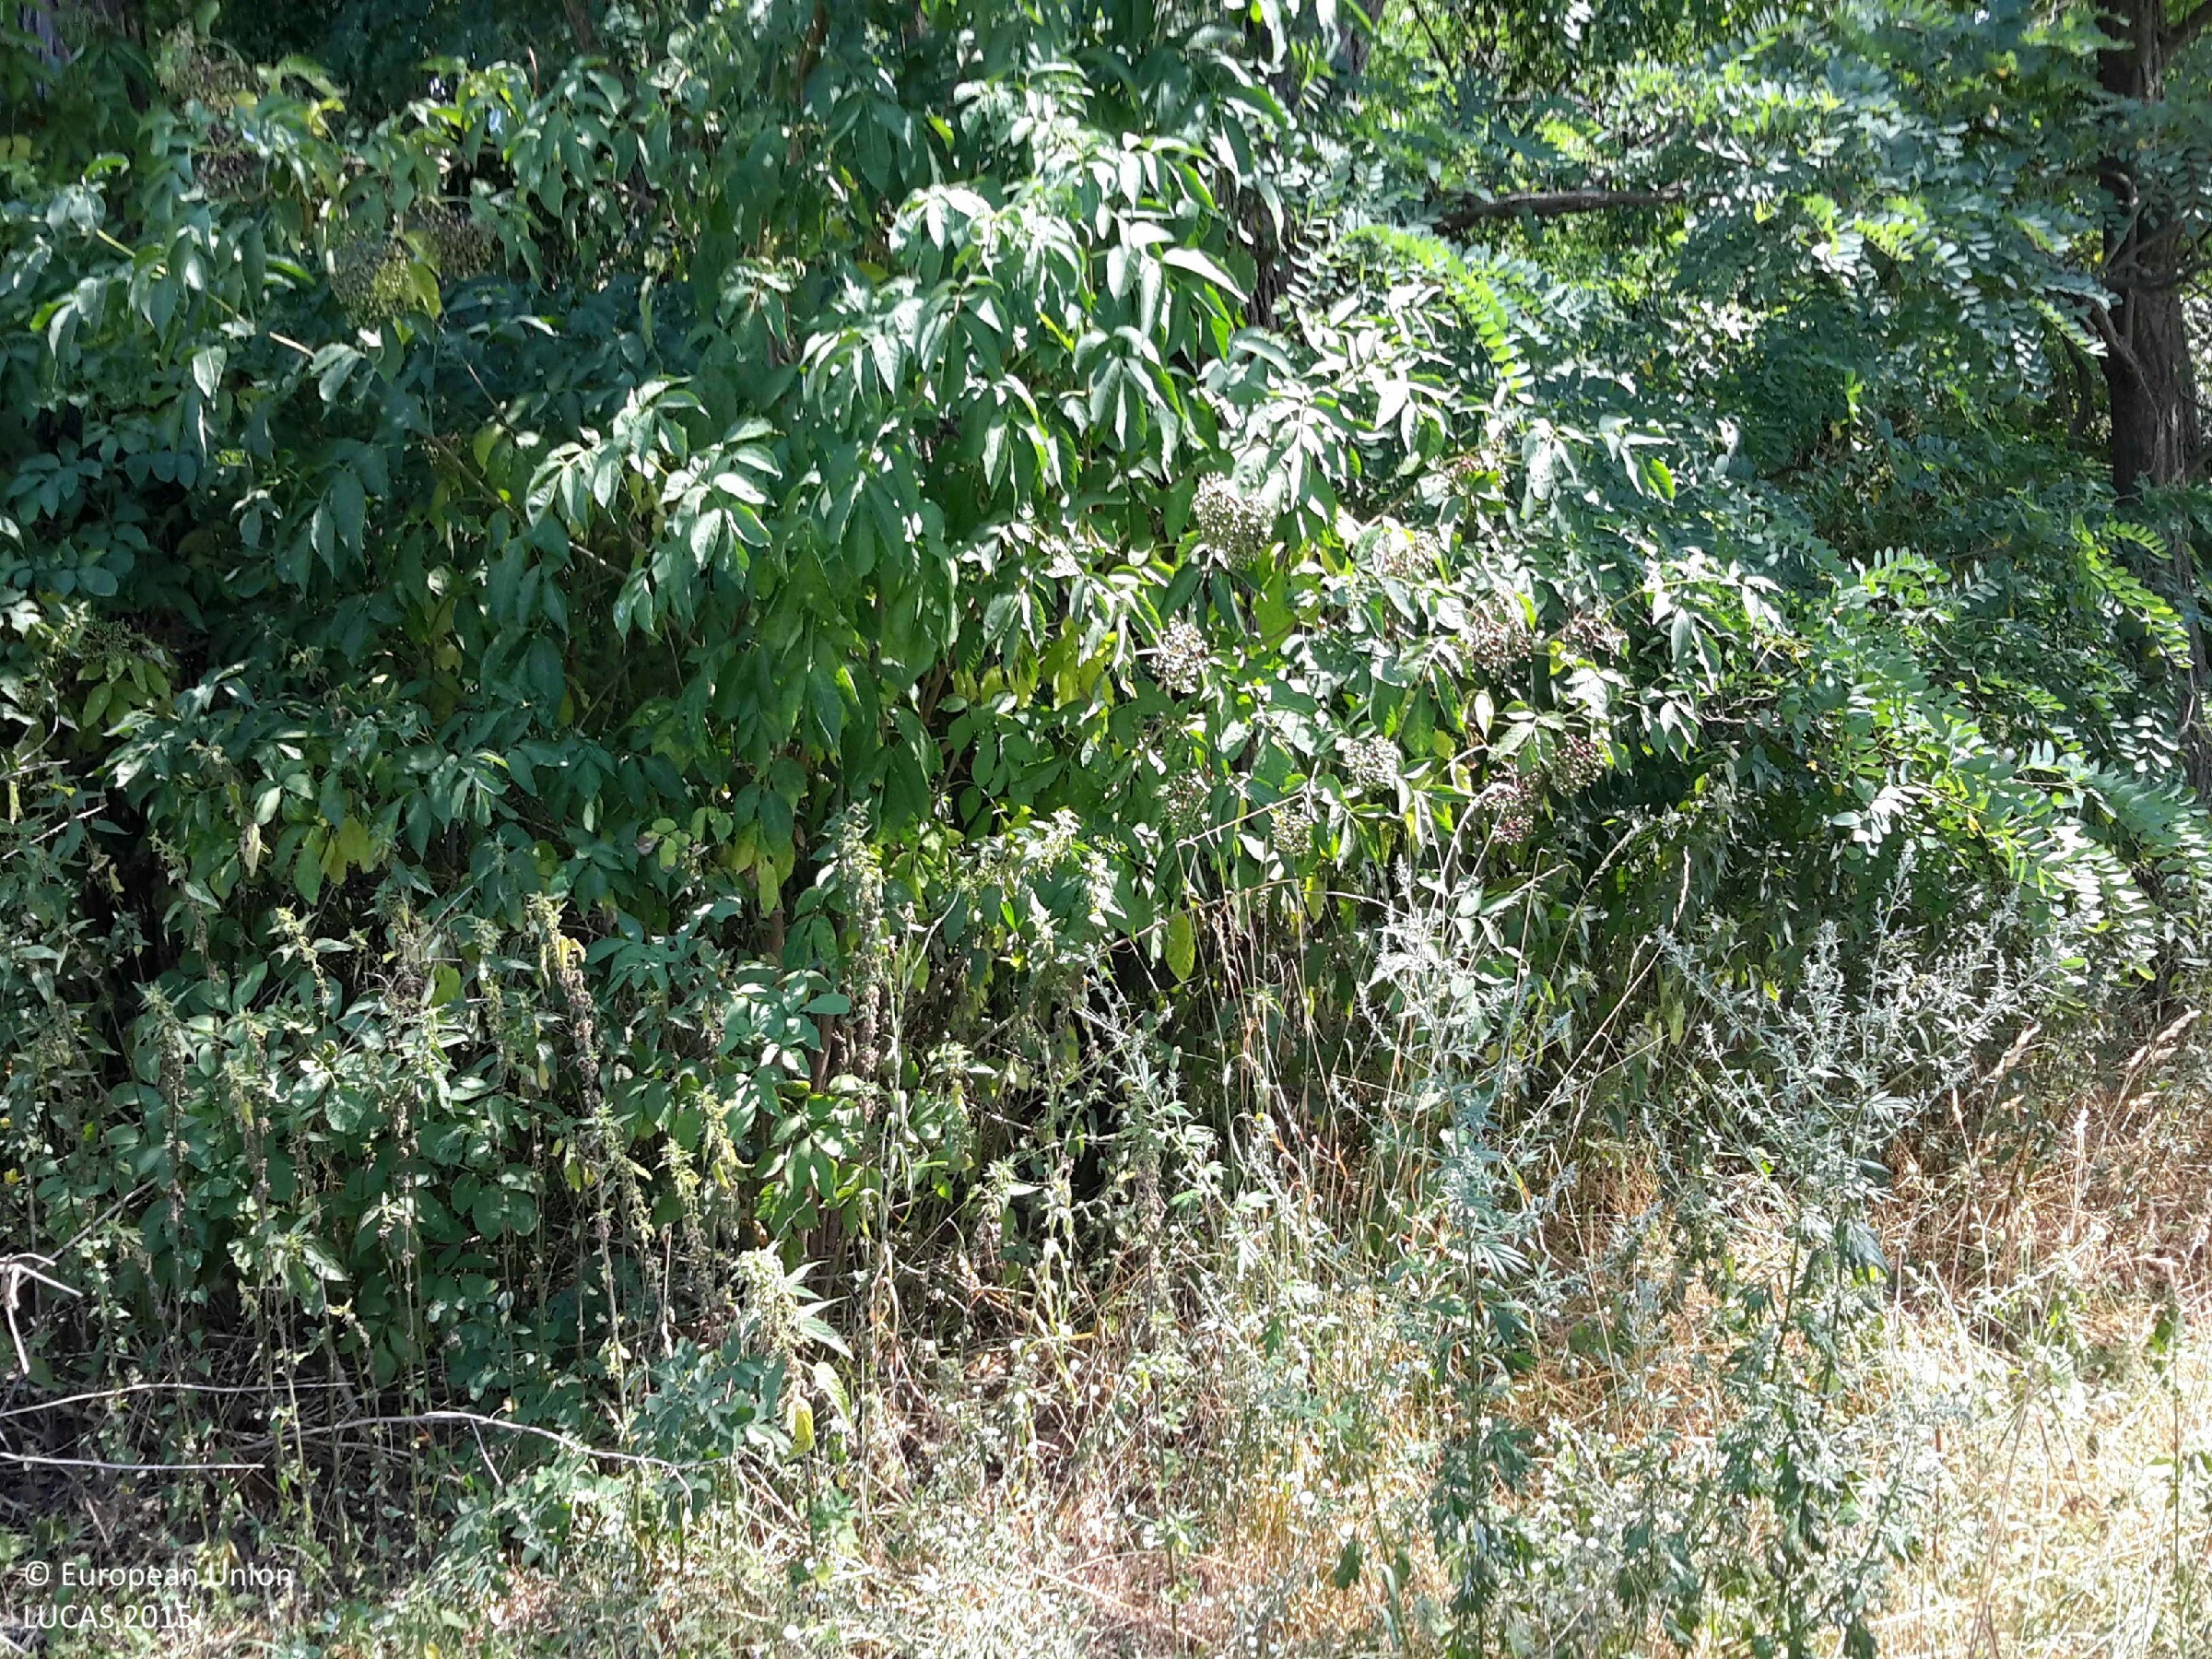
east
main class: Cropland
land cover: Permanent crops (only in case pi)
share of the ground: > 75 %
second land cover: Grassland without tree/shrub cover
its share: 50 - 75 %
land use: Agriculture (excluding fallow land and kitchen gardens)
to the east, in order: Permanent crops (only in case pi); Grassland without tree/shrub cover; Fences; Broadleaved woodland
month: July
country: HU
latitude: 47.4016
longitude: 17.8406
